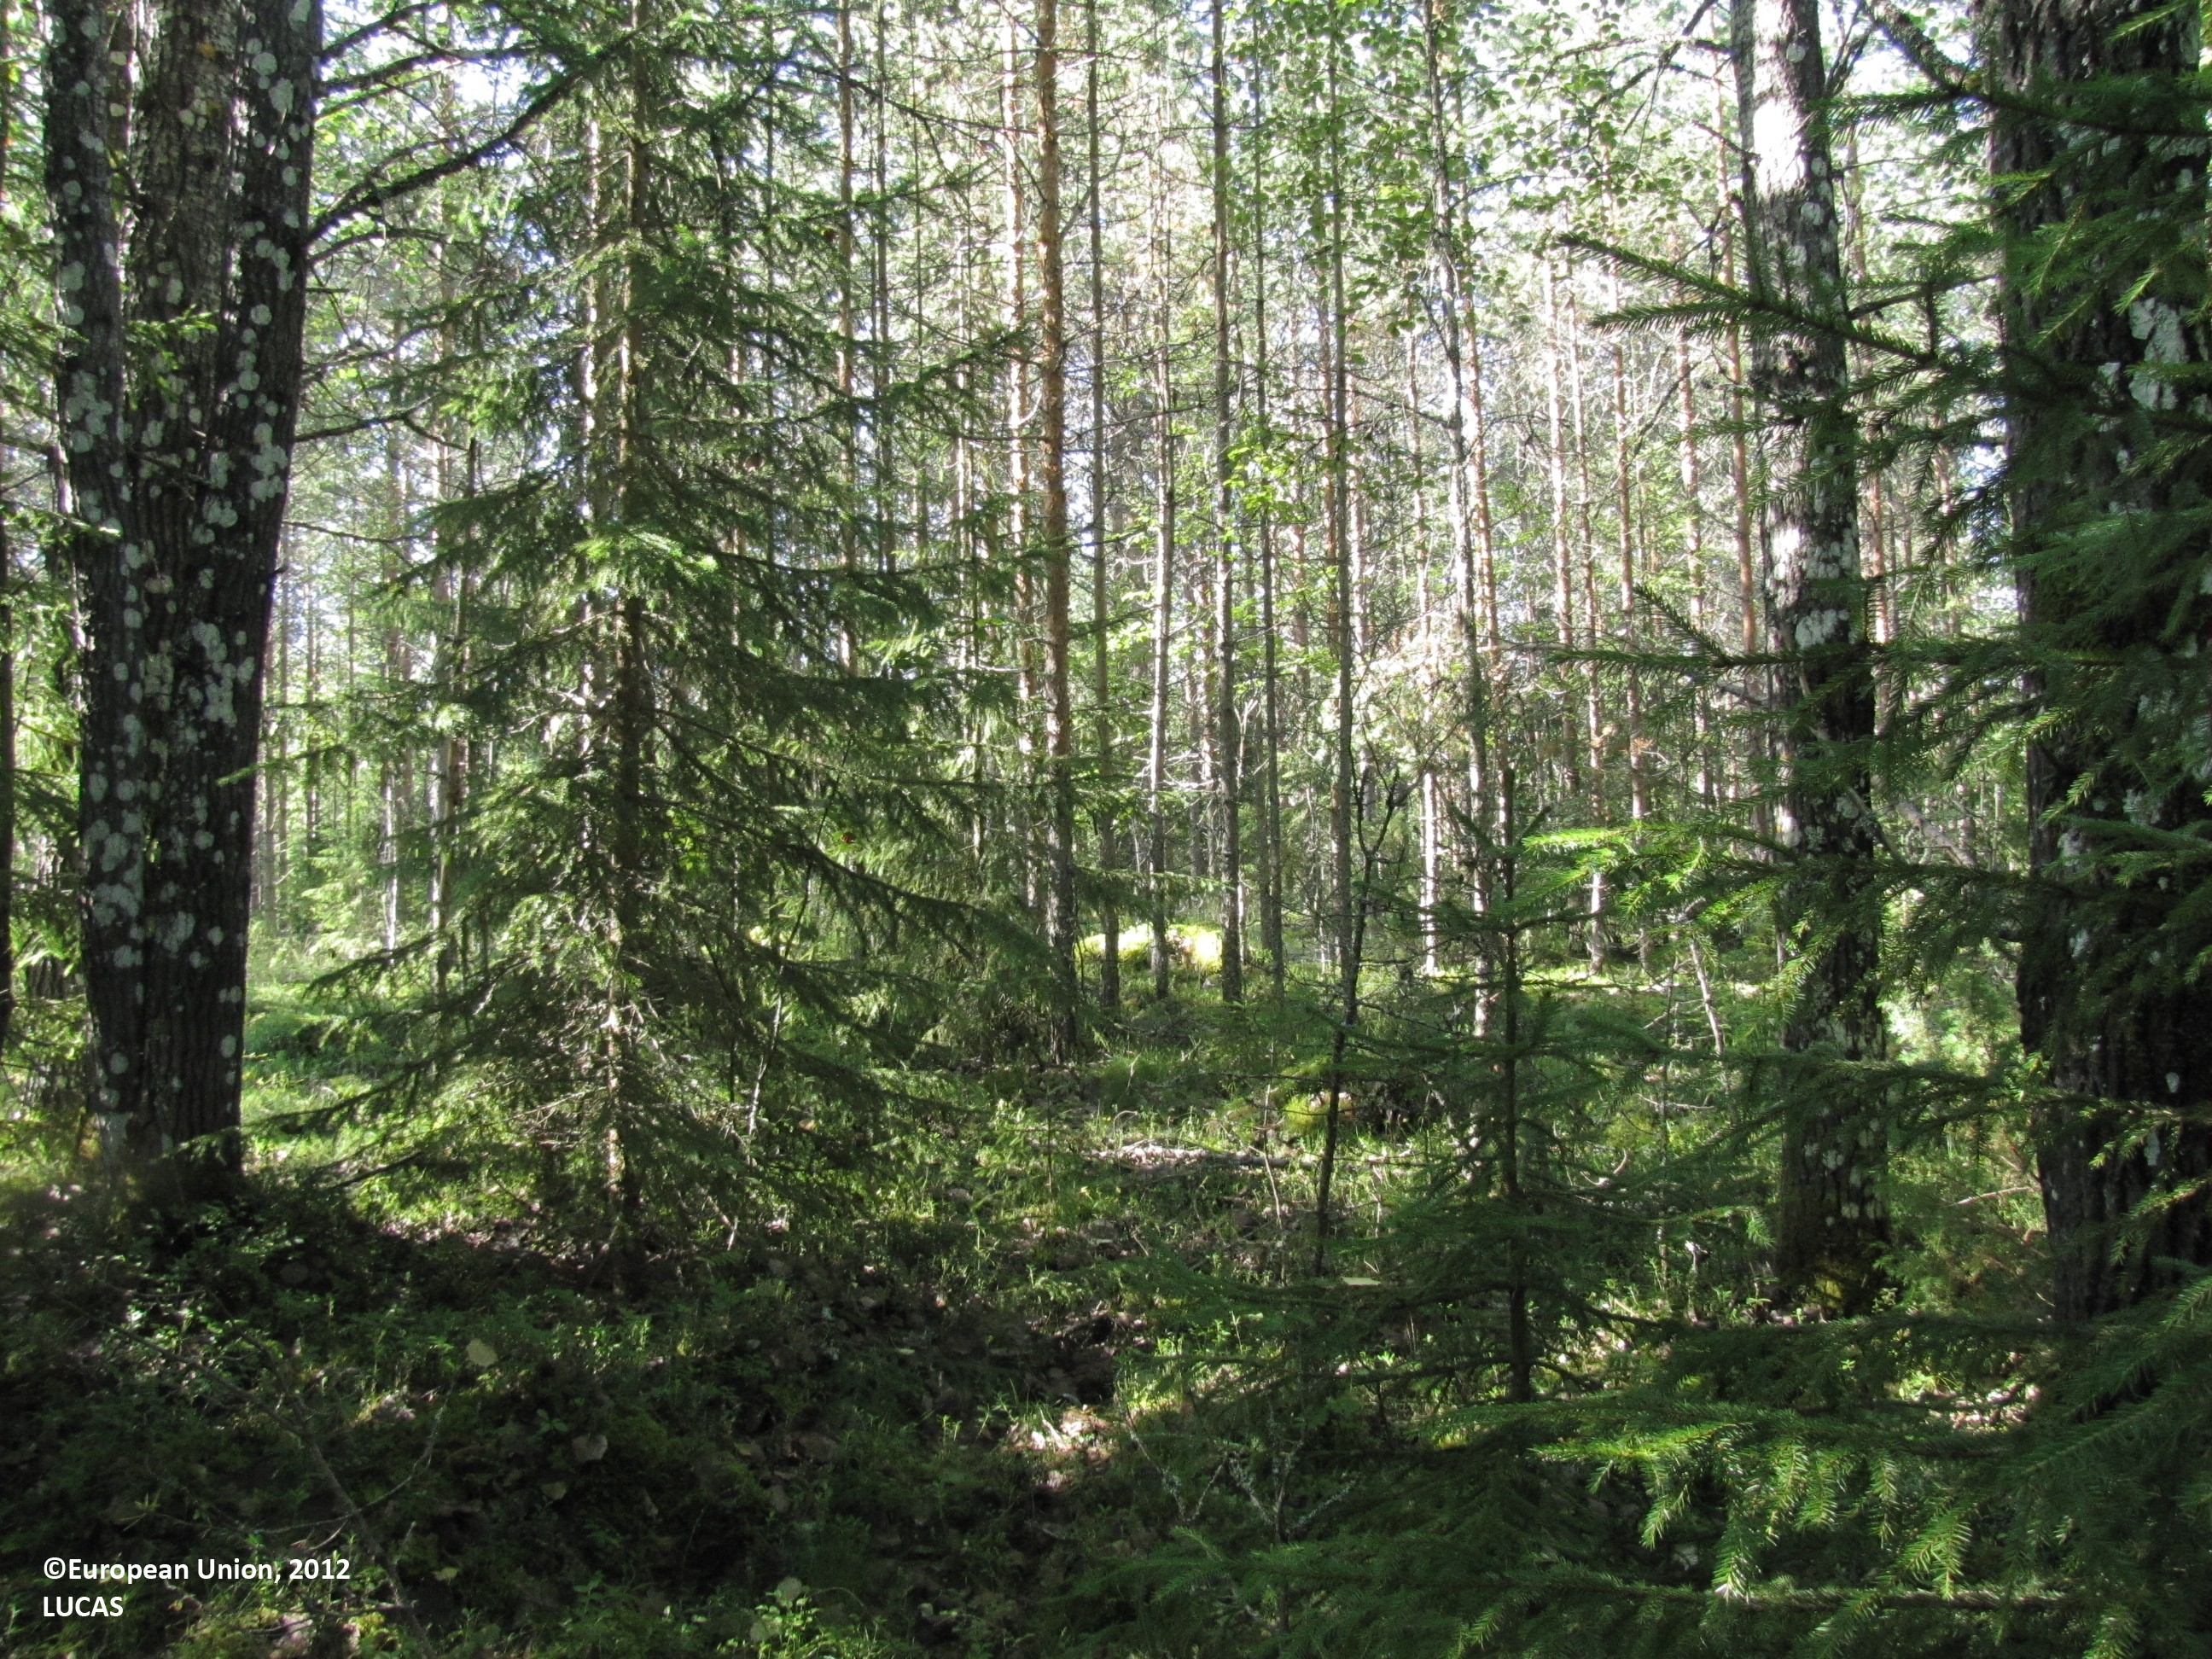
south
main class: Woodland
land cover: Other mixed woodland
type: boreal forest
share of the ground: > 75 %
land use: Forestry
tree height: > 5 m
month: July
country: FI
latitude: 62.0910
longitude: 23.1099
